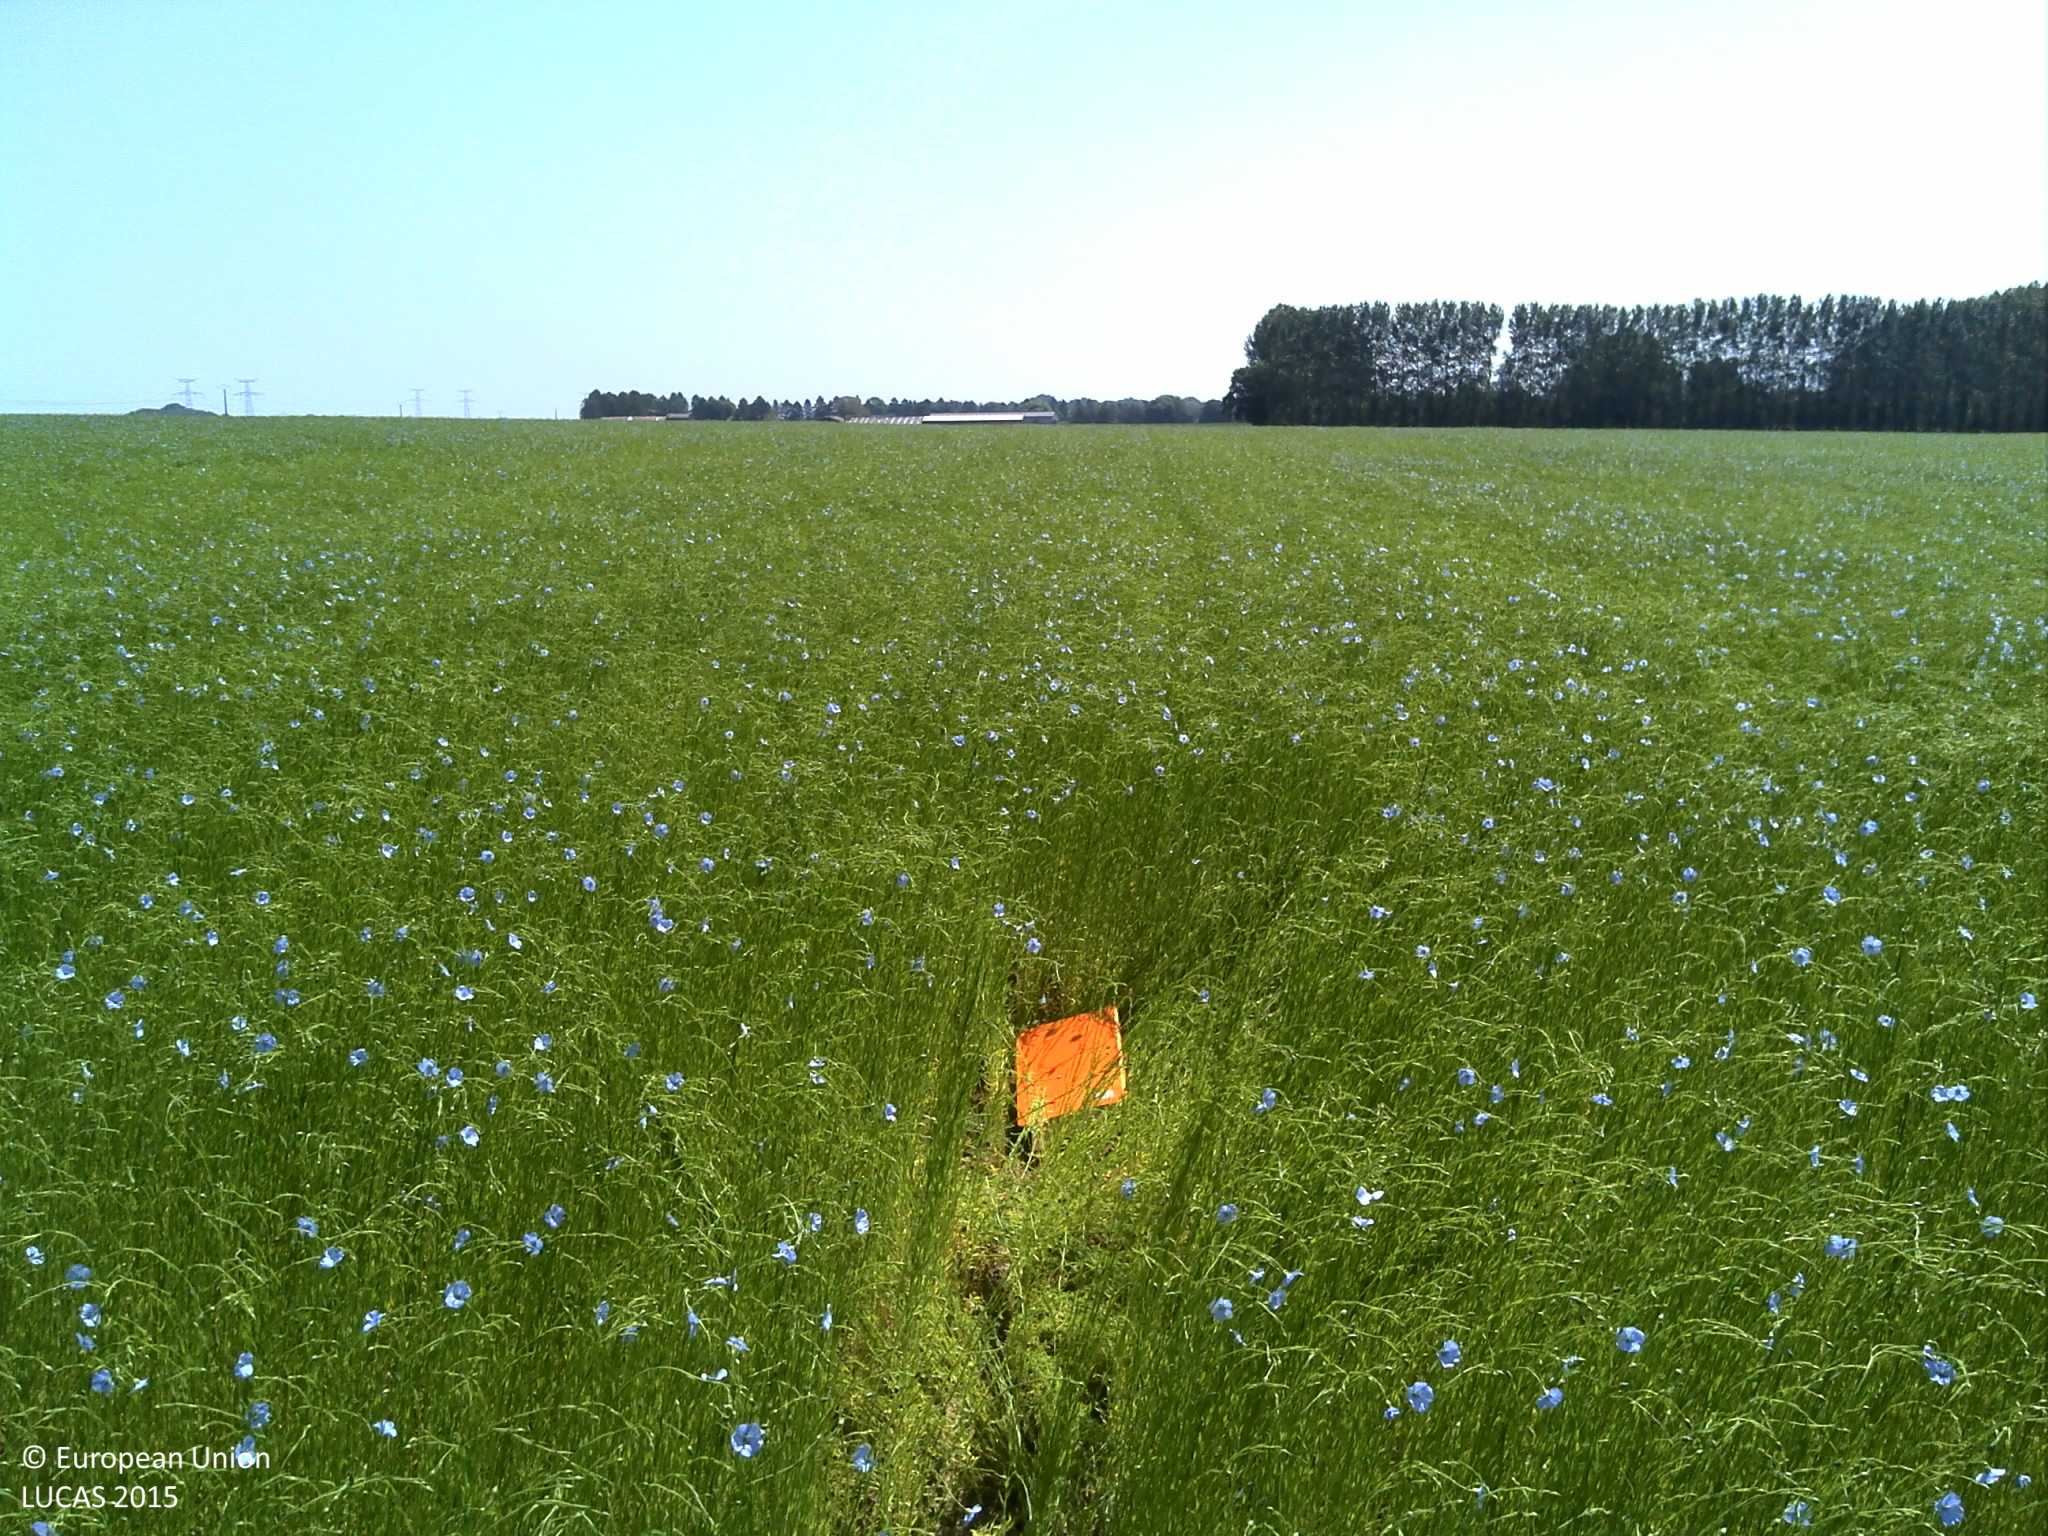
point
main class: Cropland
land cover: Other fibre and oleaginous crops
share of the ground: > 75 %
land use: Agriculture (excluding fallow land and kitchen gardens)
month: June
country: FR
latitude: 49.5876
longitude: 1.1675
